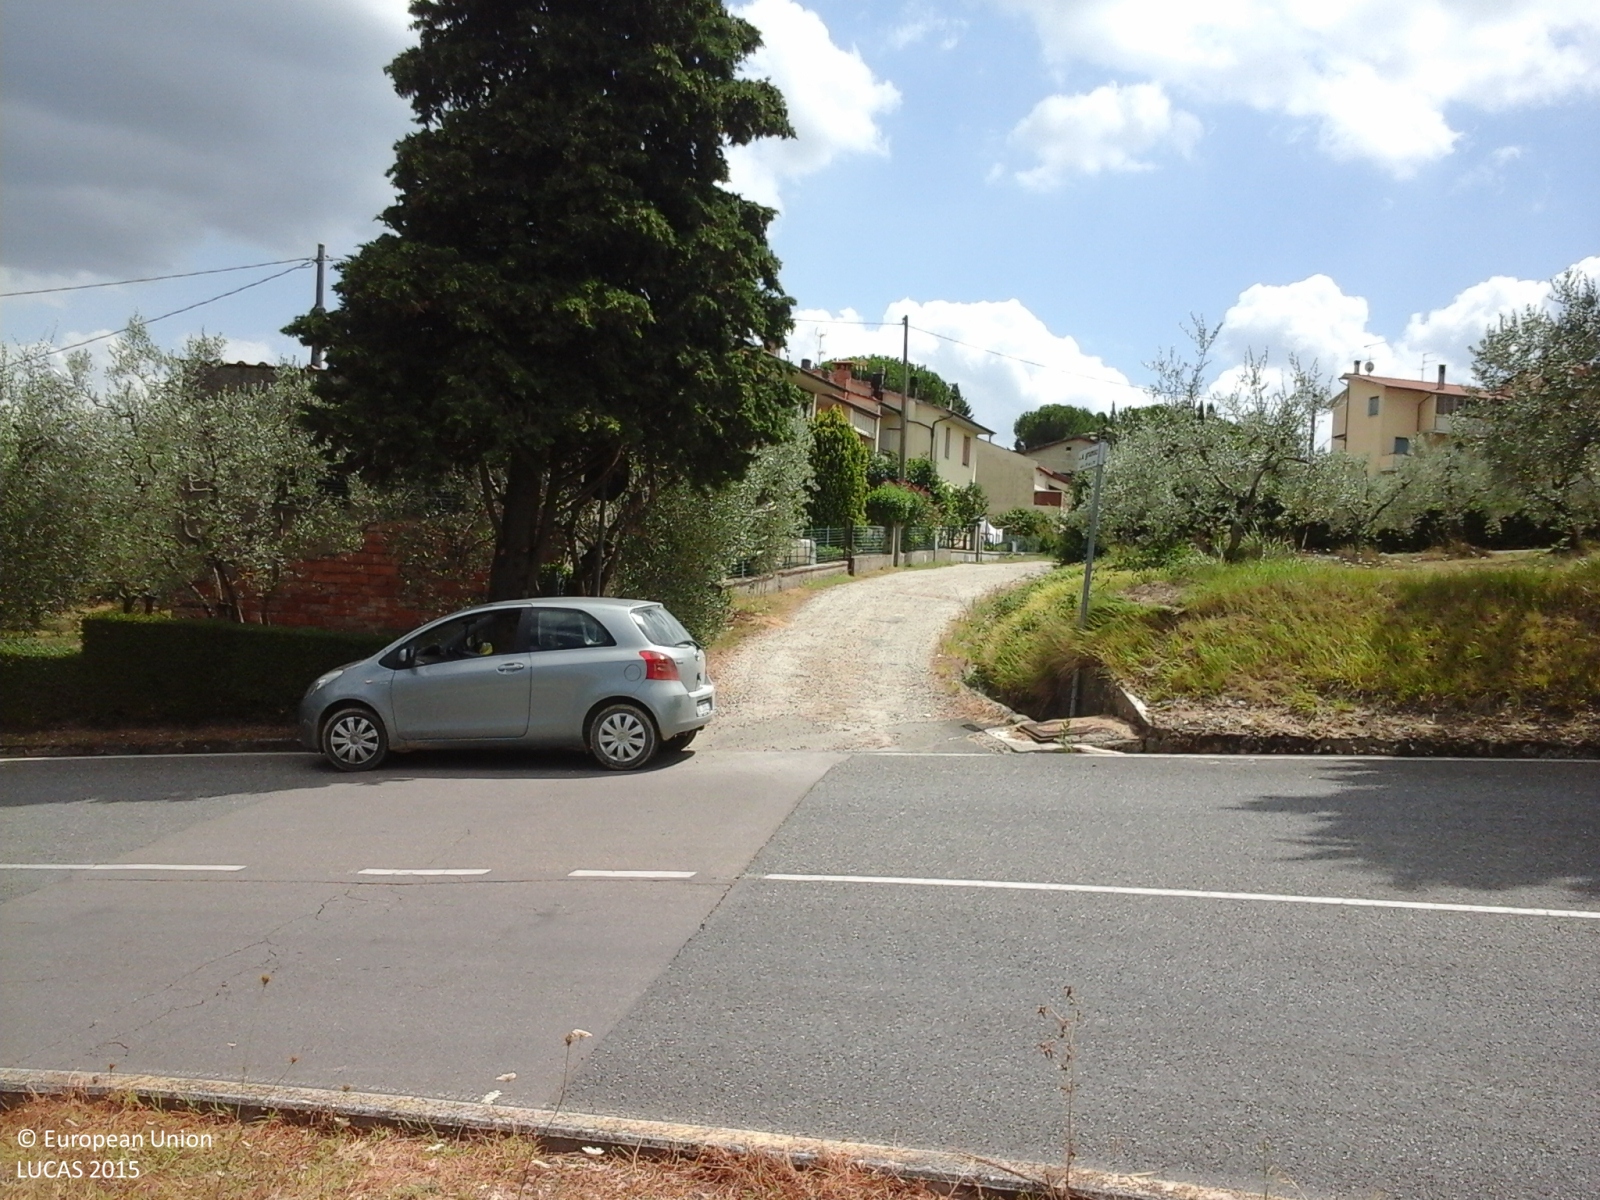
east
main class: Cropland
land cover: Olive groves
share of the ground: > 75 %
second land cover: Spontaneously vegetated surfaces
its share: > 75 %
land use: Agriculture (excluding fallow land and kitchen gardens)
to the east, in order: Olive groves; Spontaneously vegetated surfaces; Paved roads, cycling and walking lanes; Spontaneously vegetated surfaces; Artificial constructions in urban areas; Broadleaved woodland
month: July
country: IT
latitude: 43.5343
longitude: 10.9502
